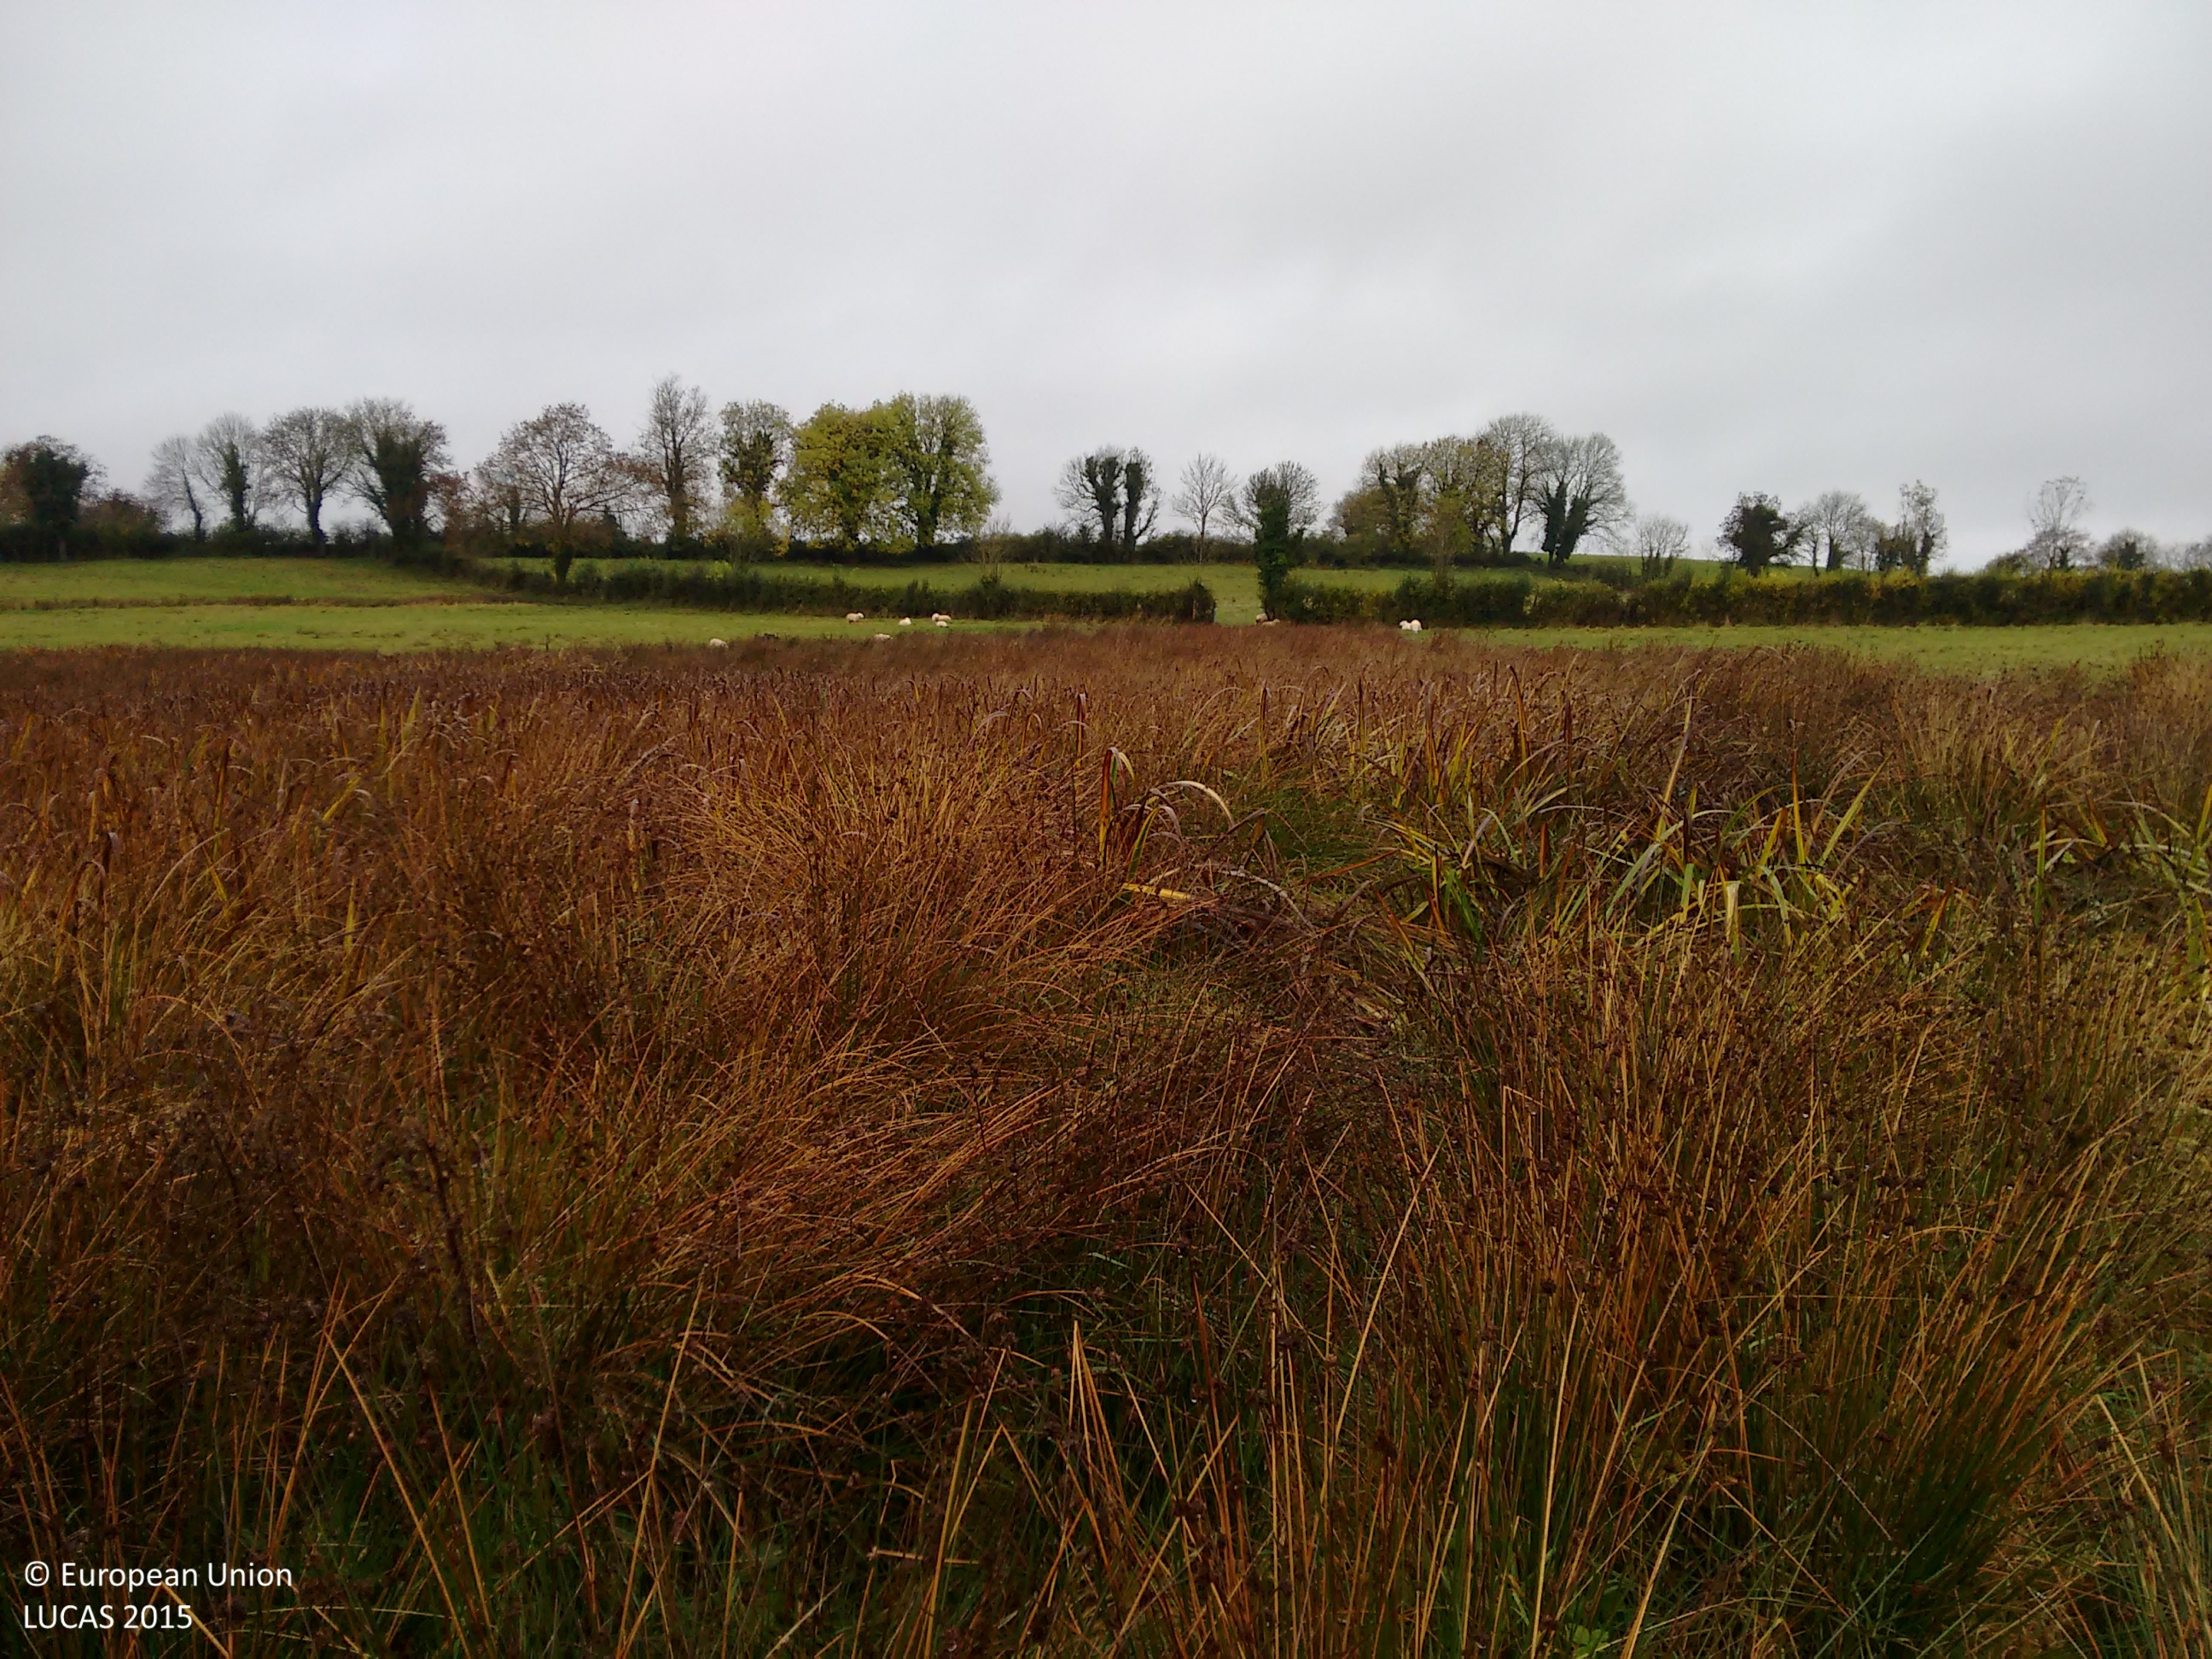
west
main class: Grassland
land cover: Grassland without tree/shrub cover
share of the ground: > 75 %
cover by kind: herbaceous plants 100 %
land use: Agriculture (excluding fallow land and kitchen gardens)
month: October
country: IE
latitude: 53.8967
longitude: -8.0260
